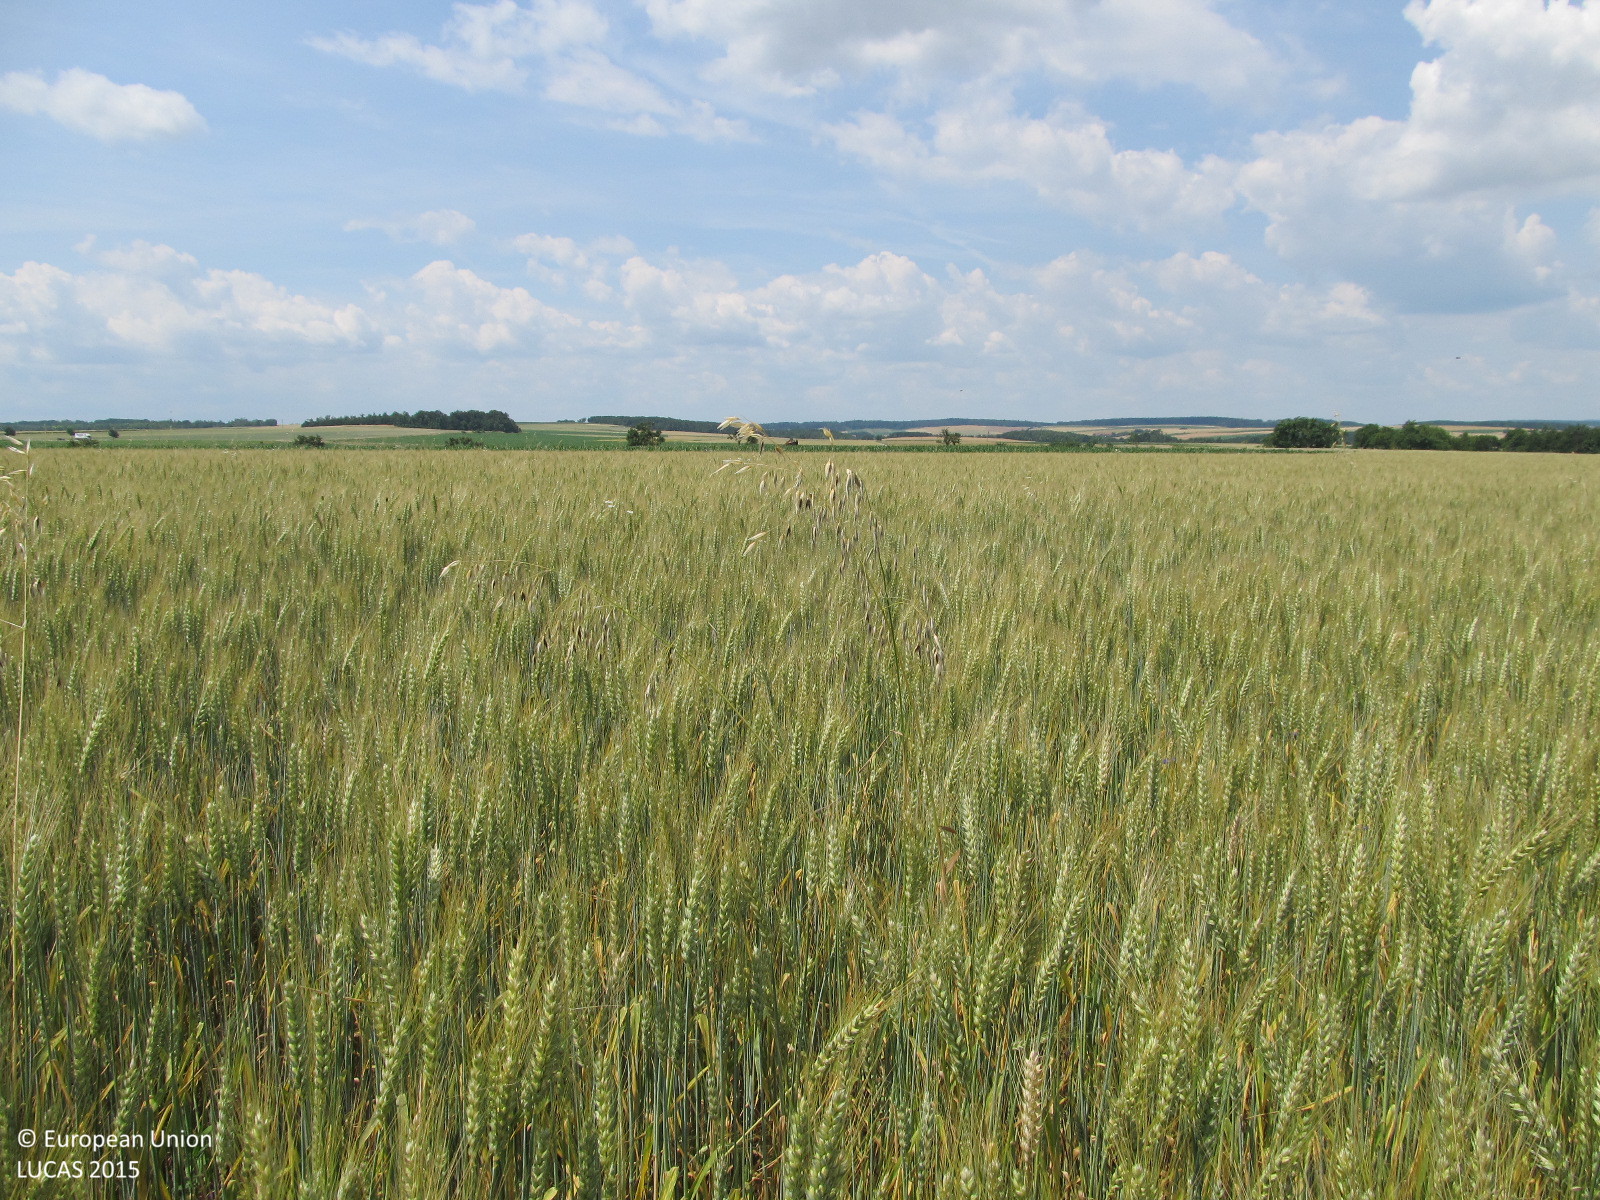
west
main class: Cropland
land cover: Common wheat
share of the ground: > 75 %
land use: Agriculture (excluding fallow land and kitchen gardens)
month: June
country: AT
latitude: 48.6288
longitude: 15.8246
